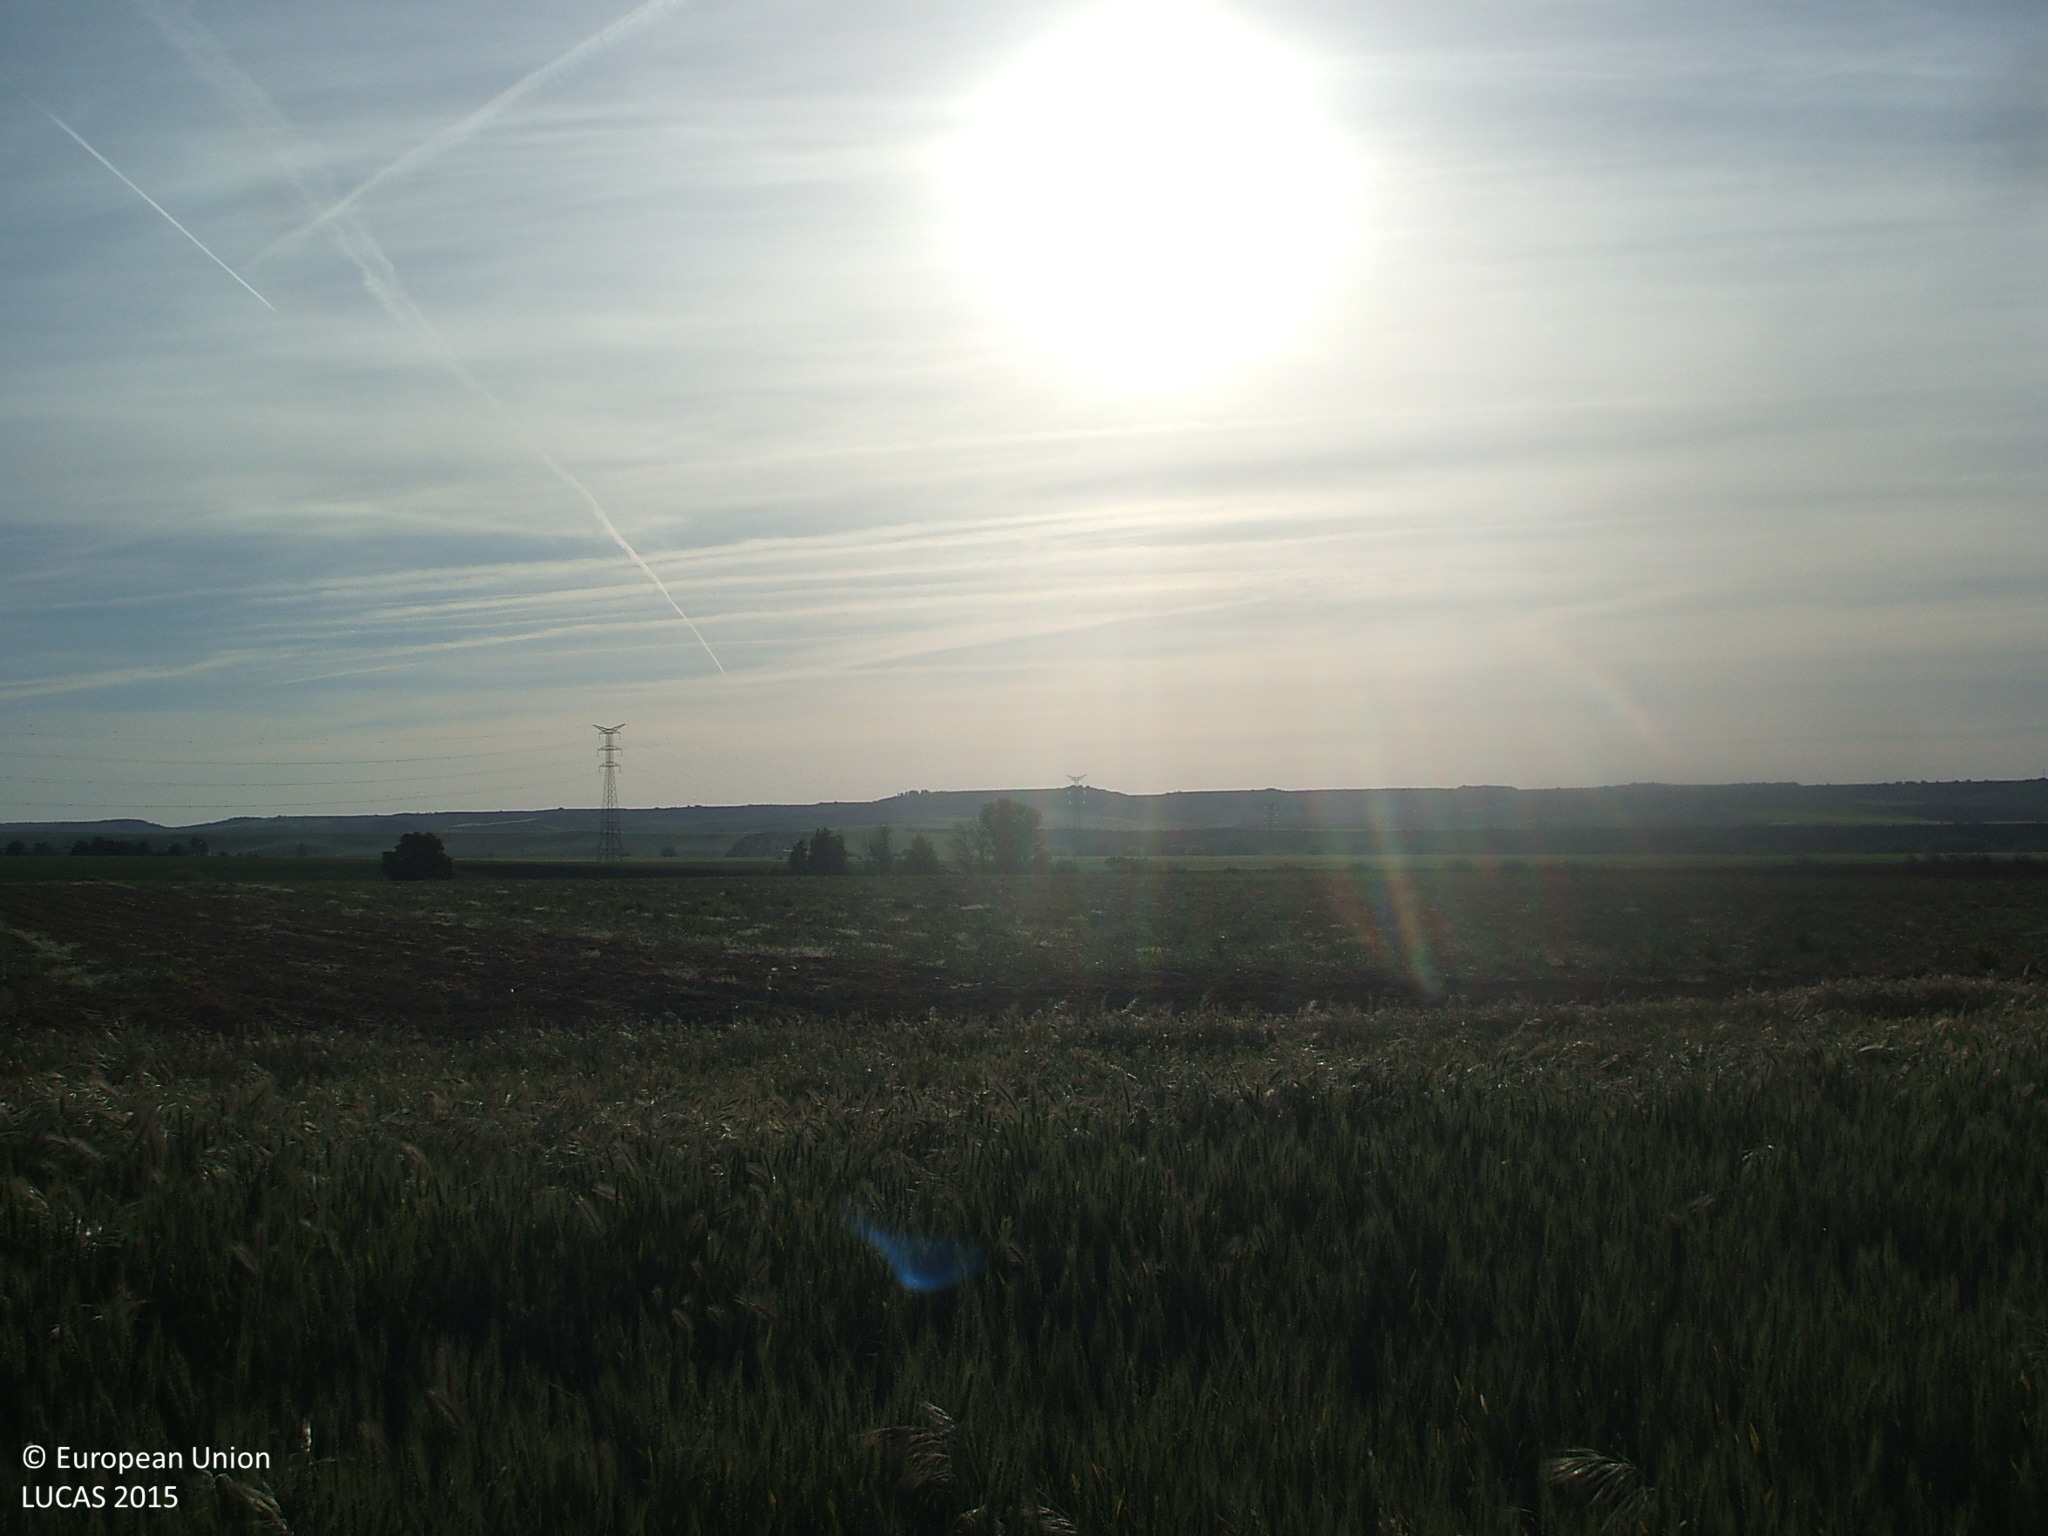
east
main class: Cropland
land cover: Common wheat
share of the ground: > 75 %
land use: Agriculture (excluding fallow land and kitchen gardens)
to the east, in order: Common wheat; Tracks; Other bare soil
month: May
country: ES
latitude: 40.7048
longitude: -3.3519
